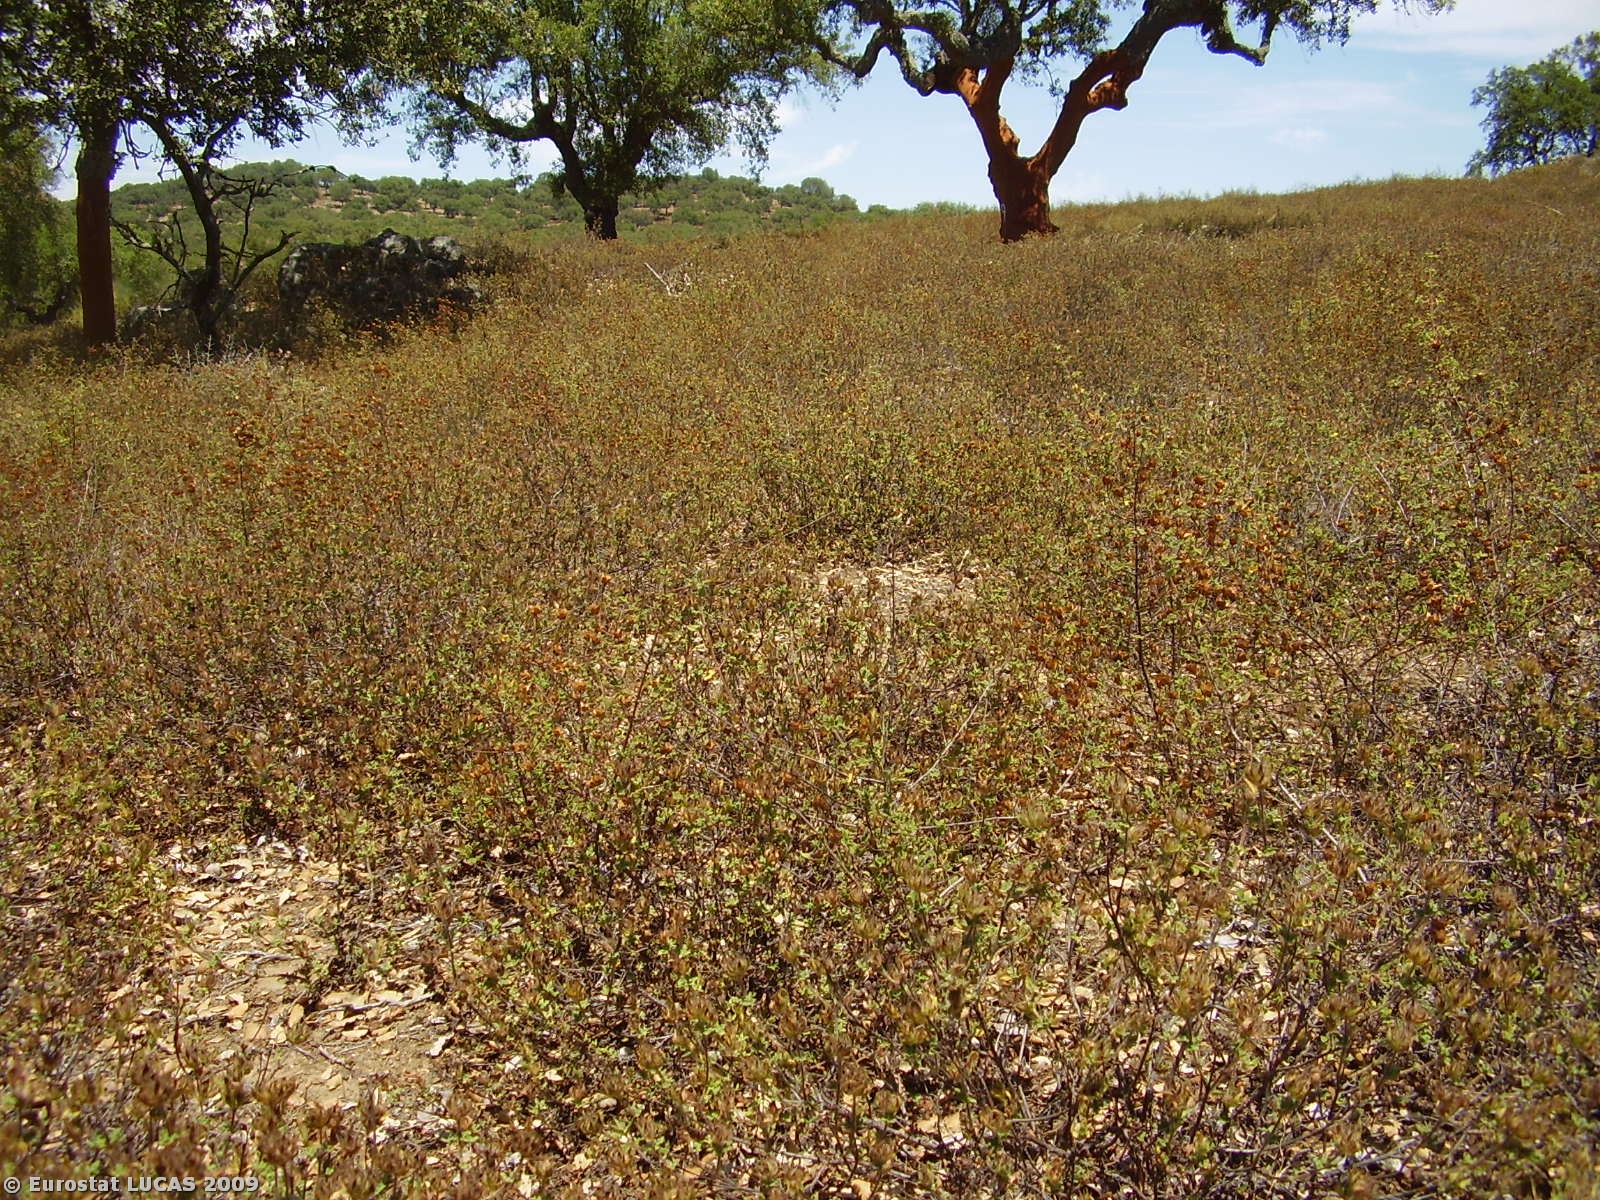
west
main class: Woodland
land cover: Broadleaved woodland
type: broadleaved evergreen forest
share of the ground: 10 - 25 %
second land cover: Spontaneously vegetated surfaces
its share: 50 - 75 %
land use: Forestry
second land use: Fallow land
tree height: > 5 m
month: July
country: PT
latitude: 38.7247
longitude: -7.8582
